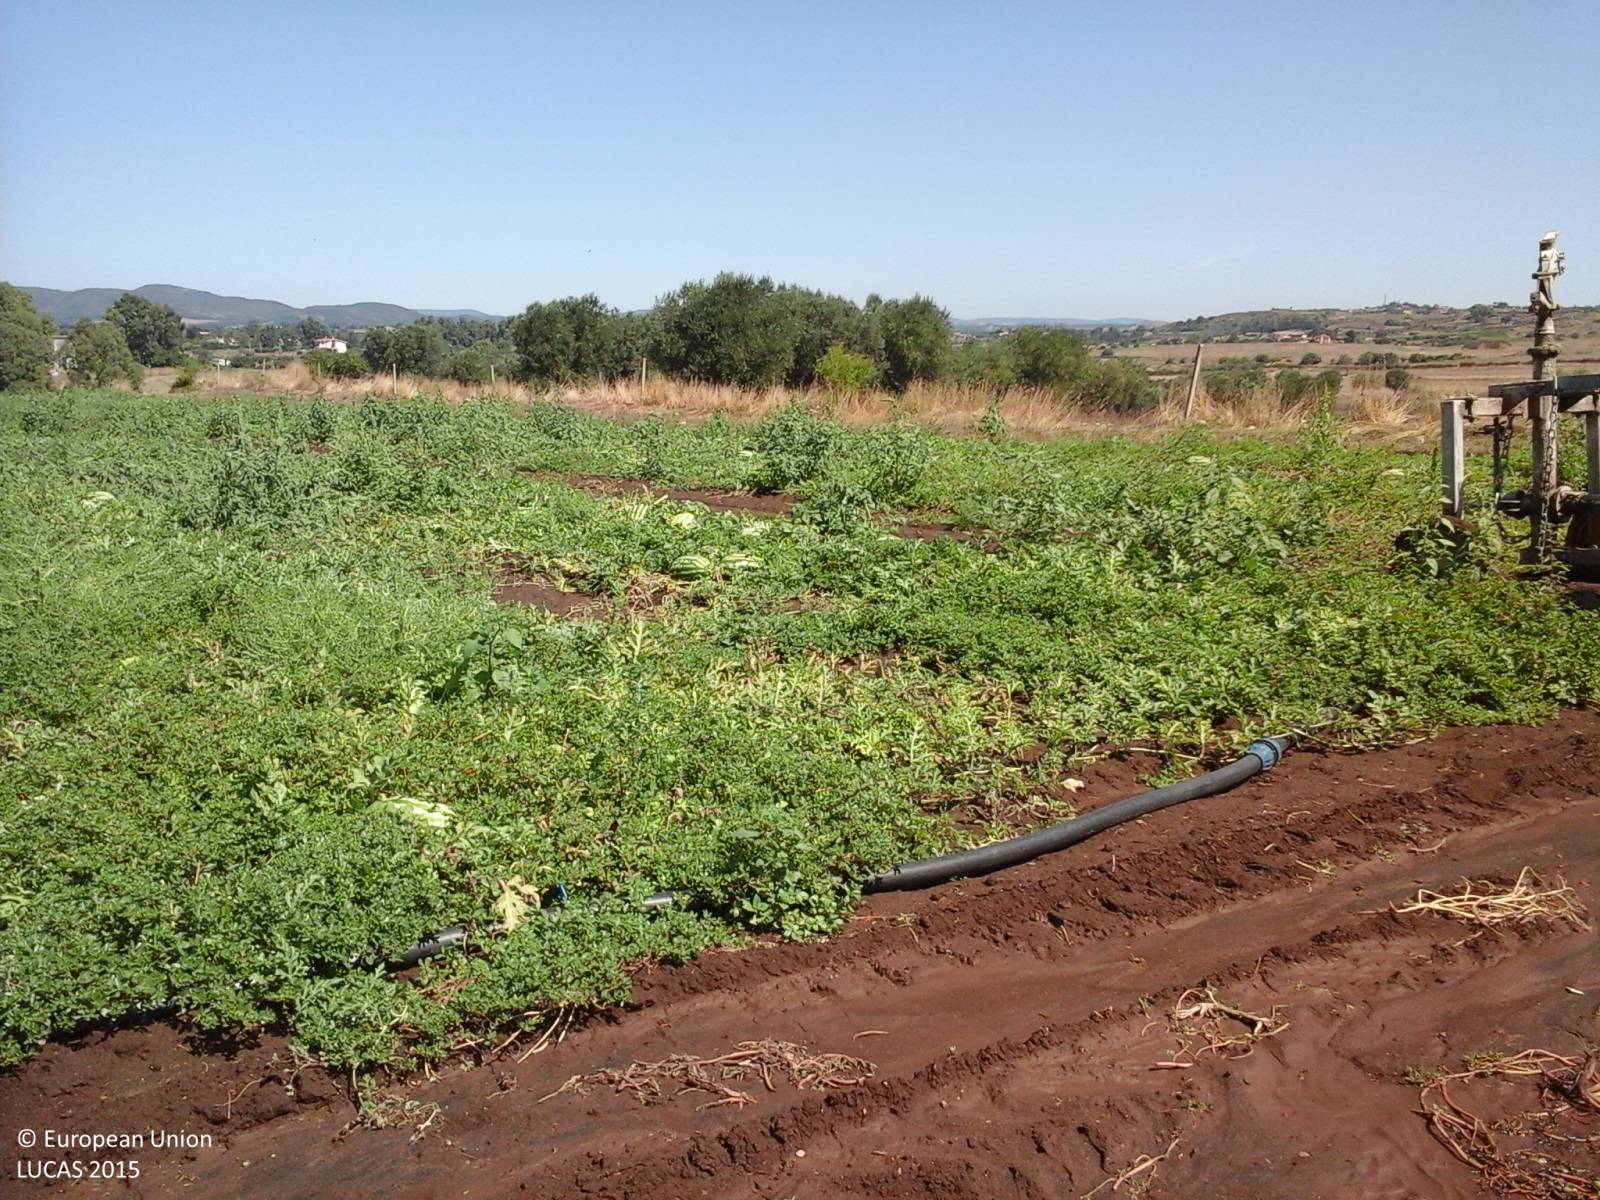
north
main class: Cropland
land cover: Other fresh vegetables
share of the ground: > 75 %
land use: Agriculture (excluding fallow land and kitchen gardens)
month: August
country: IT
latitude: 41.9625
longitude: 12.1517
